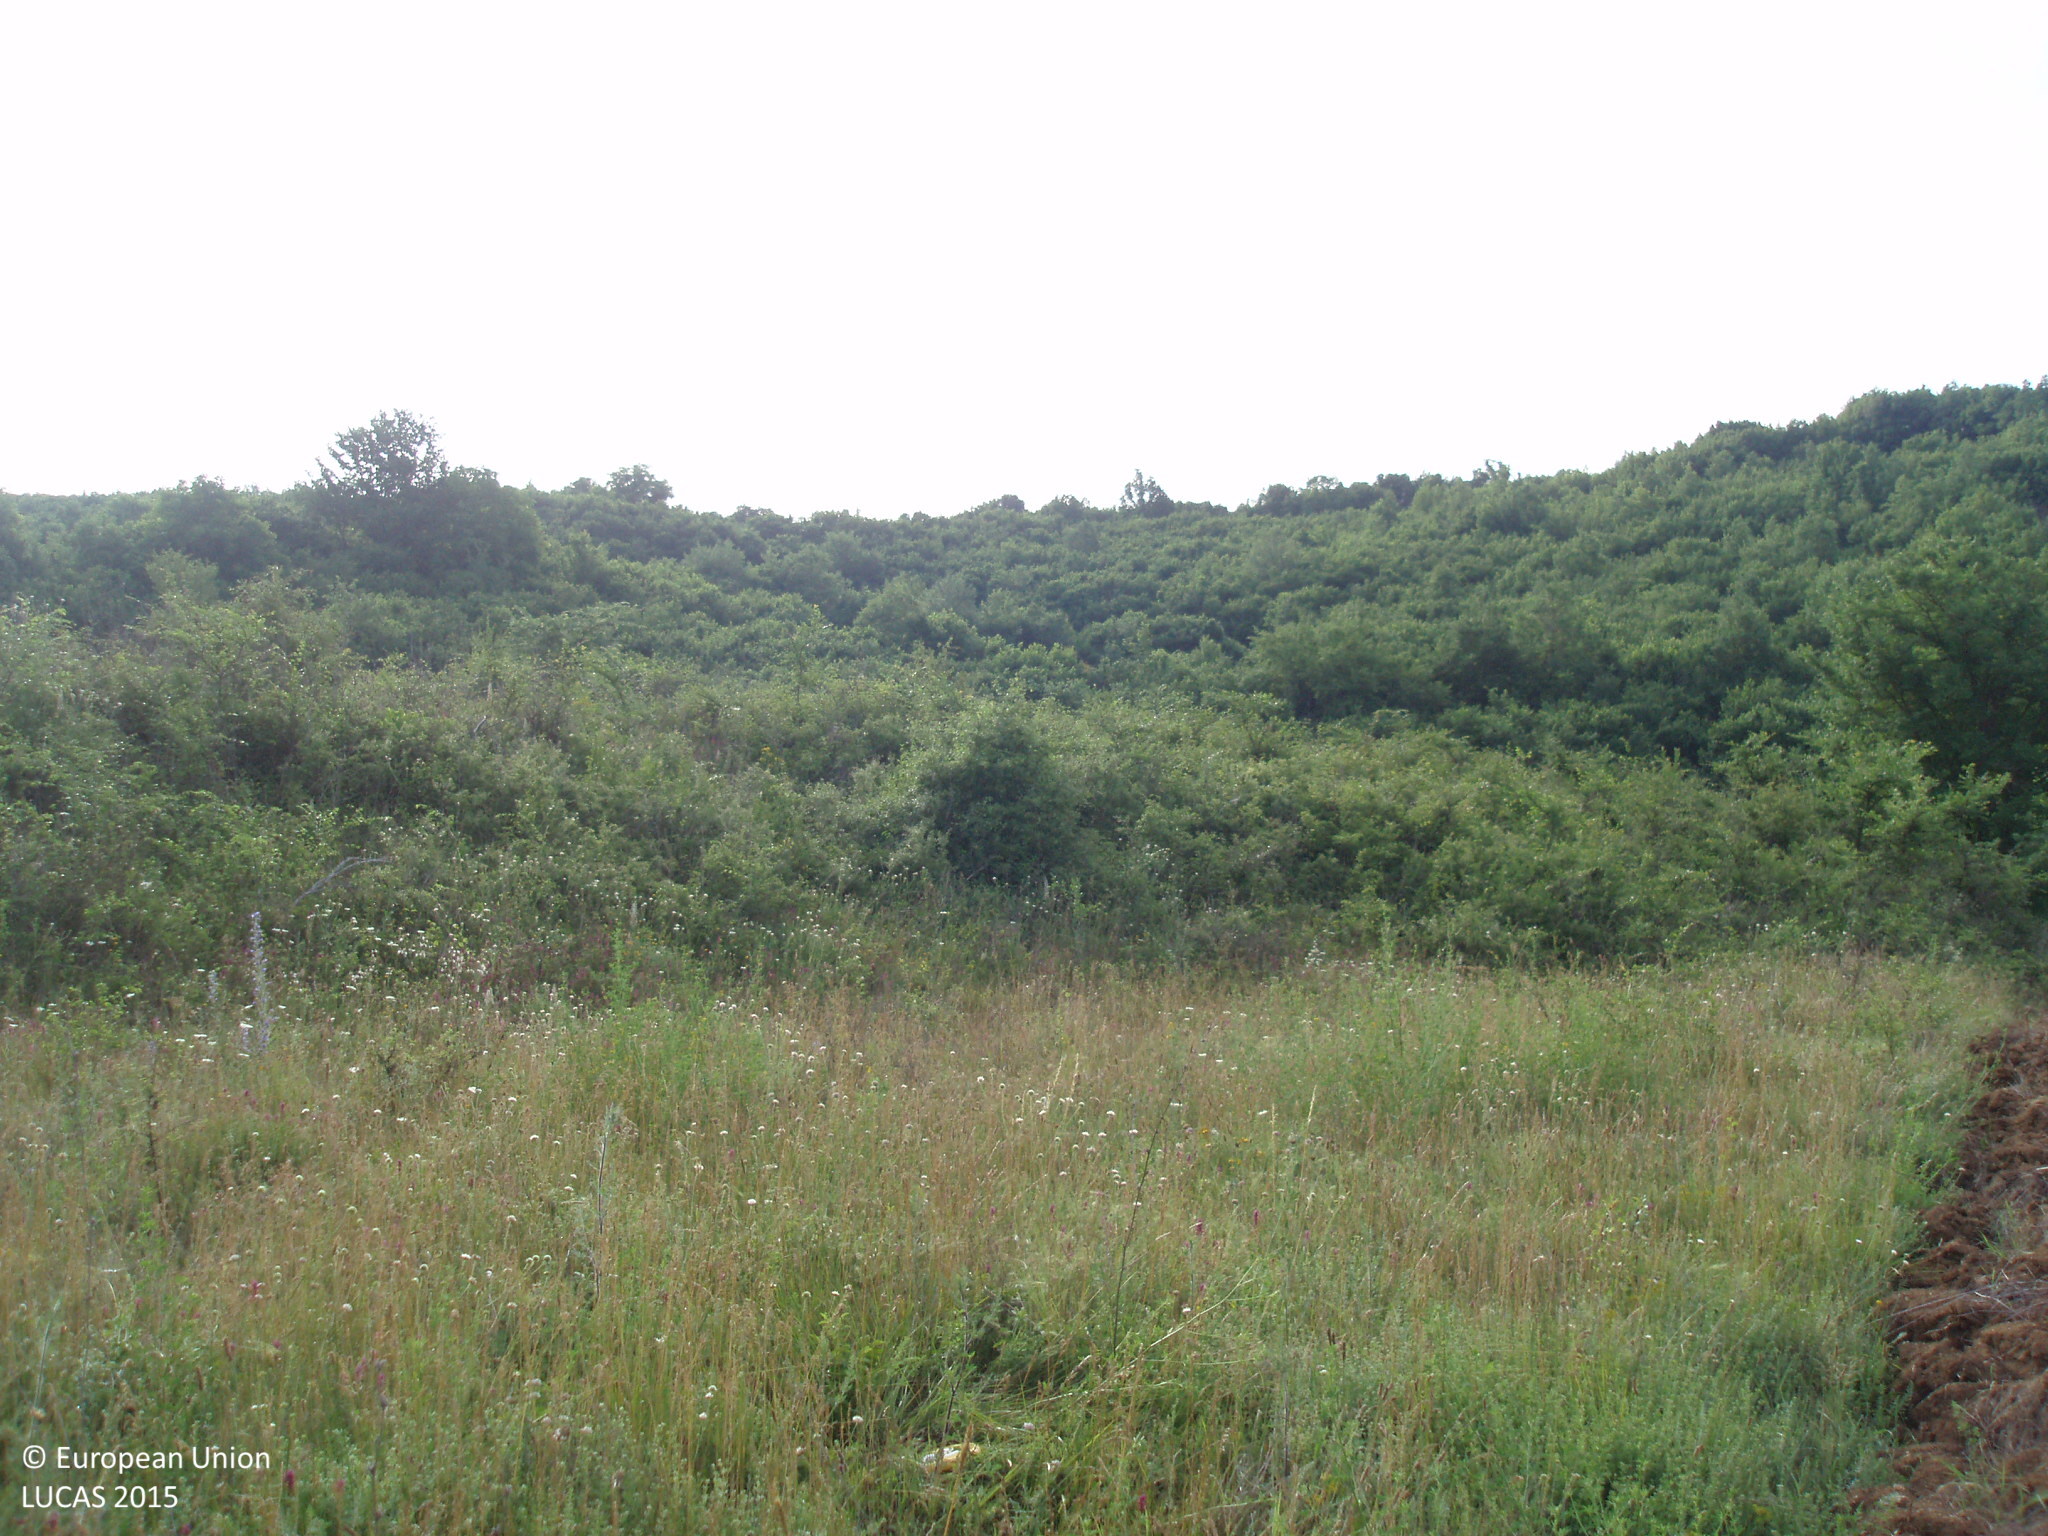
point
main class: Grassland
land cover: Grassland without tree/shrub cover
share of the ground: > 75 %
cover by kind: herbaceous plants 100 %
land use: Agriculture (excluding fallow land and kitchen gardens)
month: June
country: BG
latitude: 41.4651
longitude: 23.8091
